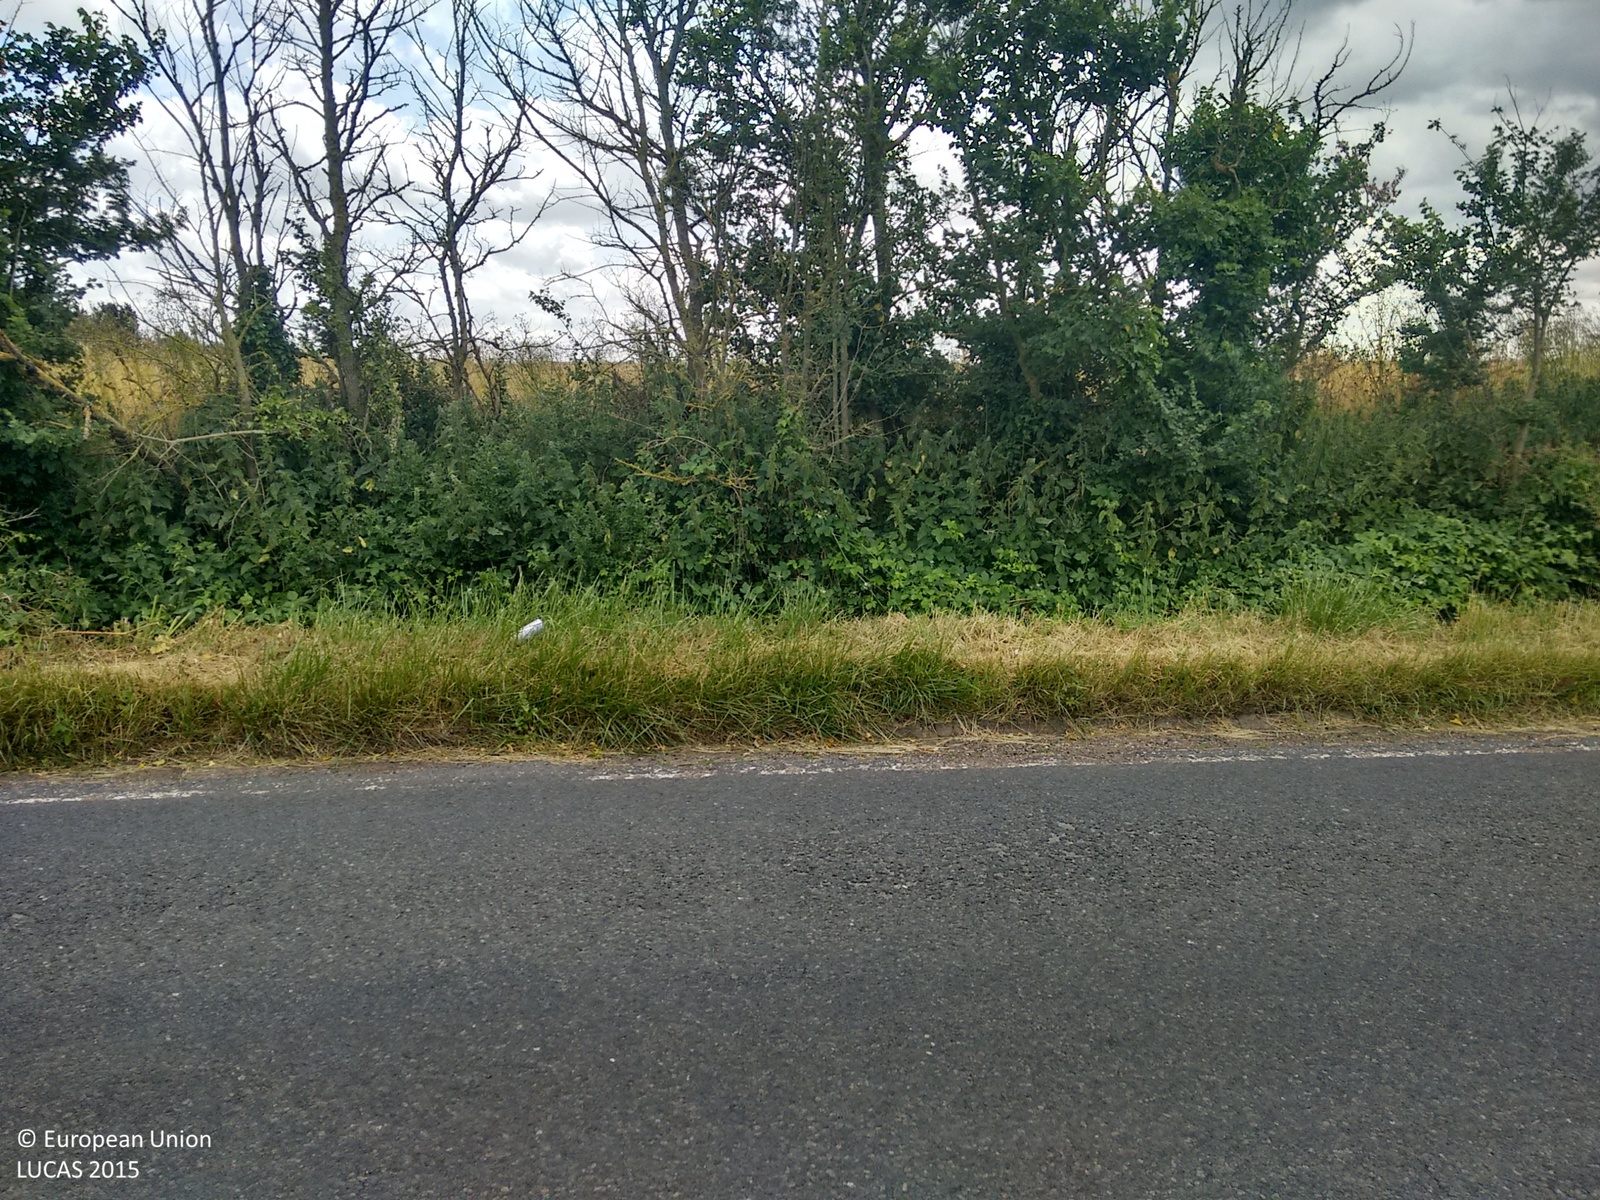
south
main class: Cropland
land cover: Barley
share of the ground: > 75 %
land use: Agriculture (excluding fallow land and kitchen gardens)
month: July
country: GB
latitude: 51.5514
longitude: 0.3805
